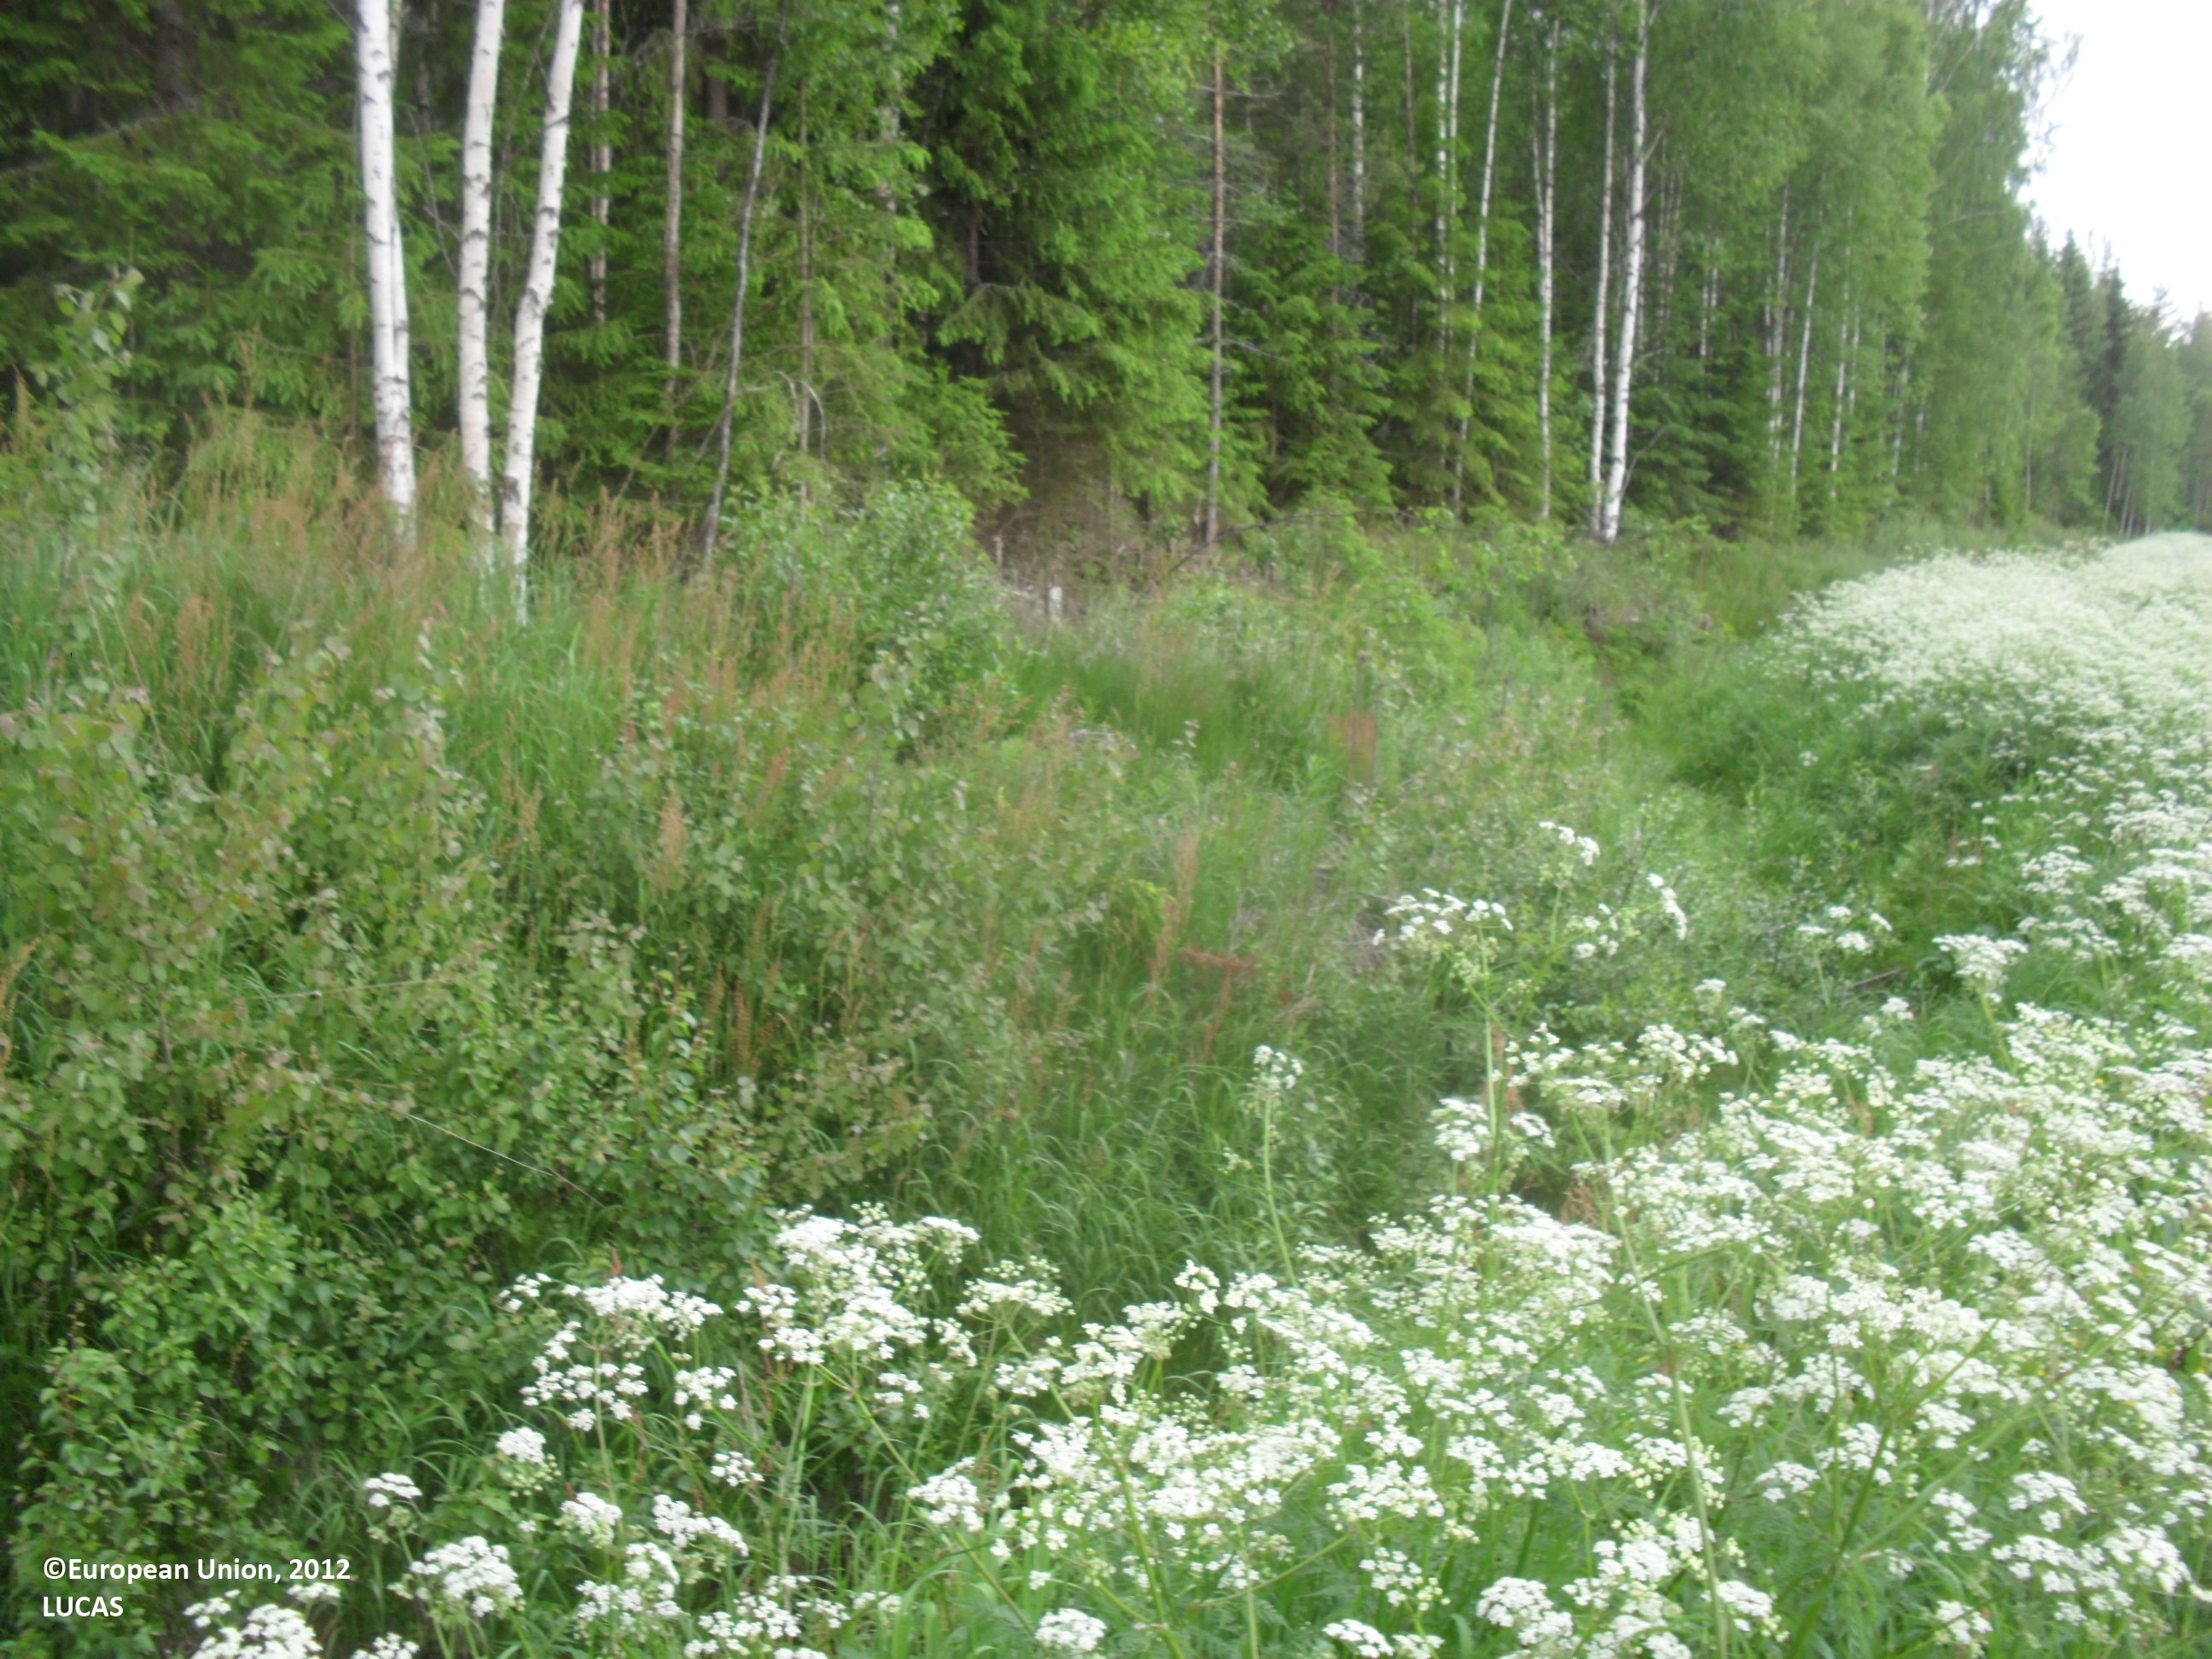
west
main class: Grassland
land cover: Grassland without tree/shrub cover
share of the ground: > 75 %
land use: Agriculture (excluding fallow land and kitchen gardens)
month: June
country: FI
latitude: 63.4831
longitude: 23.1257
